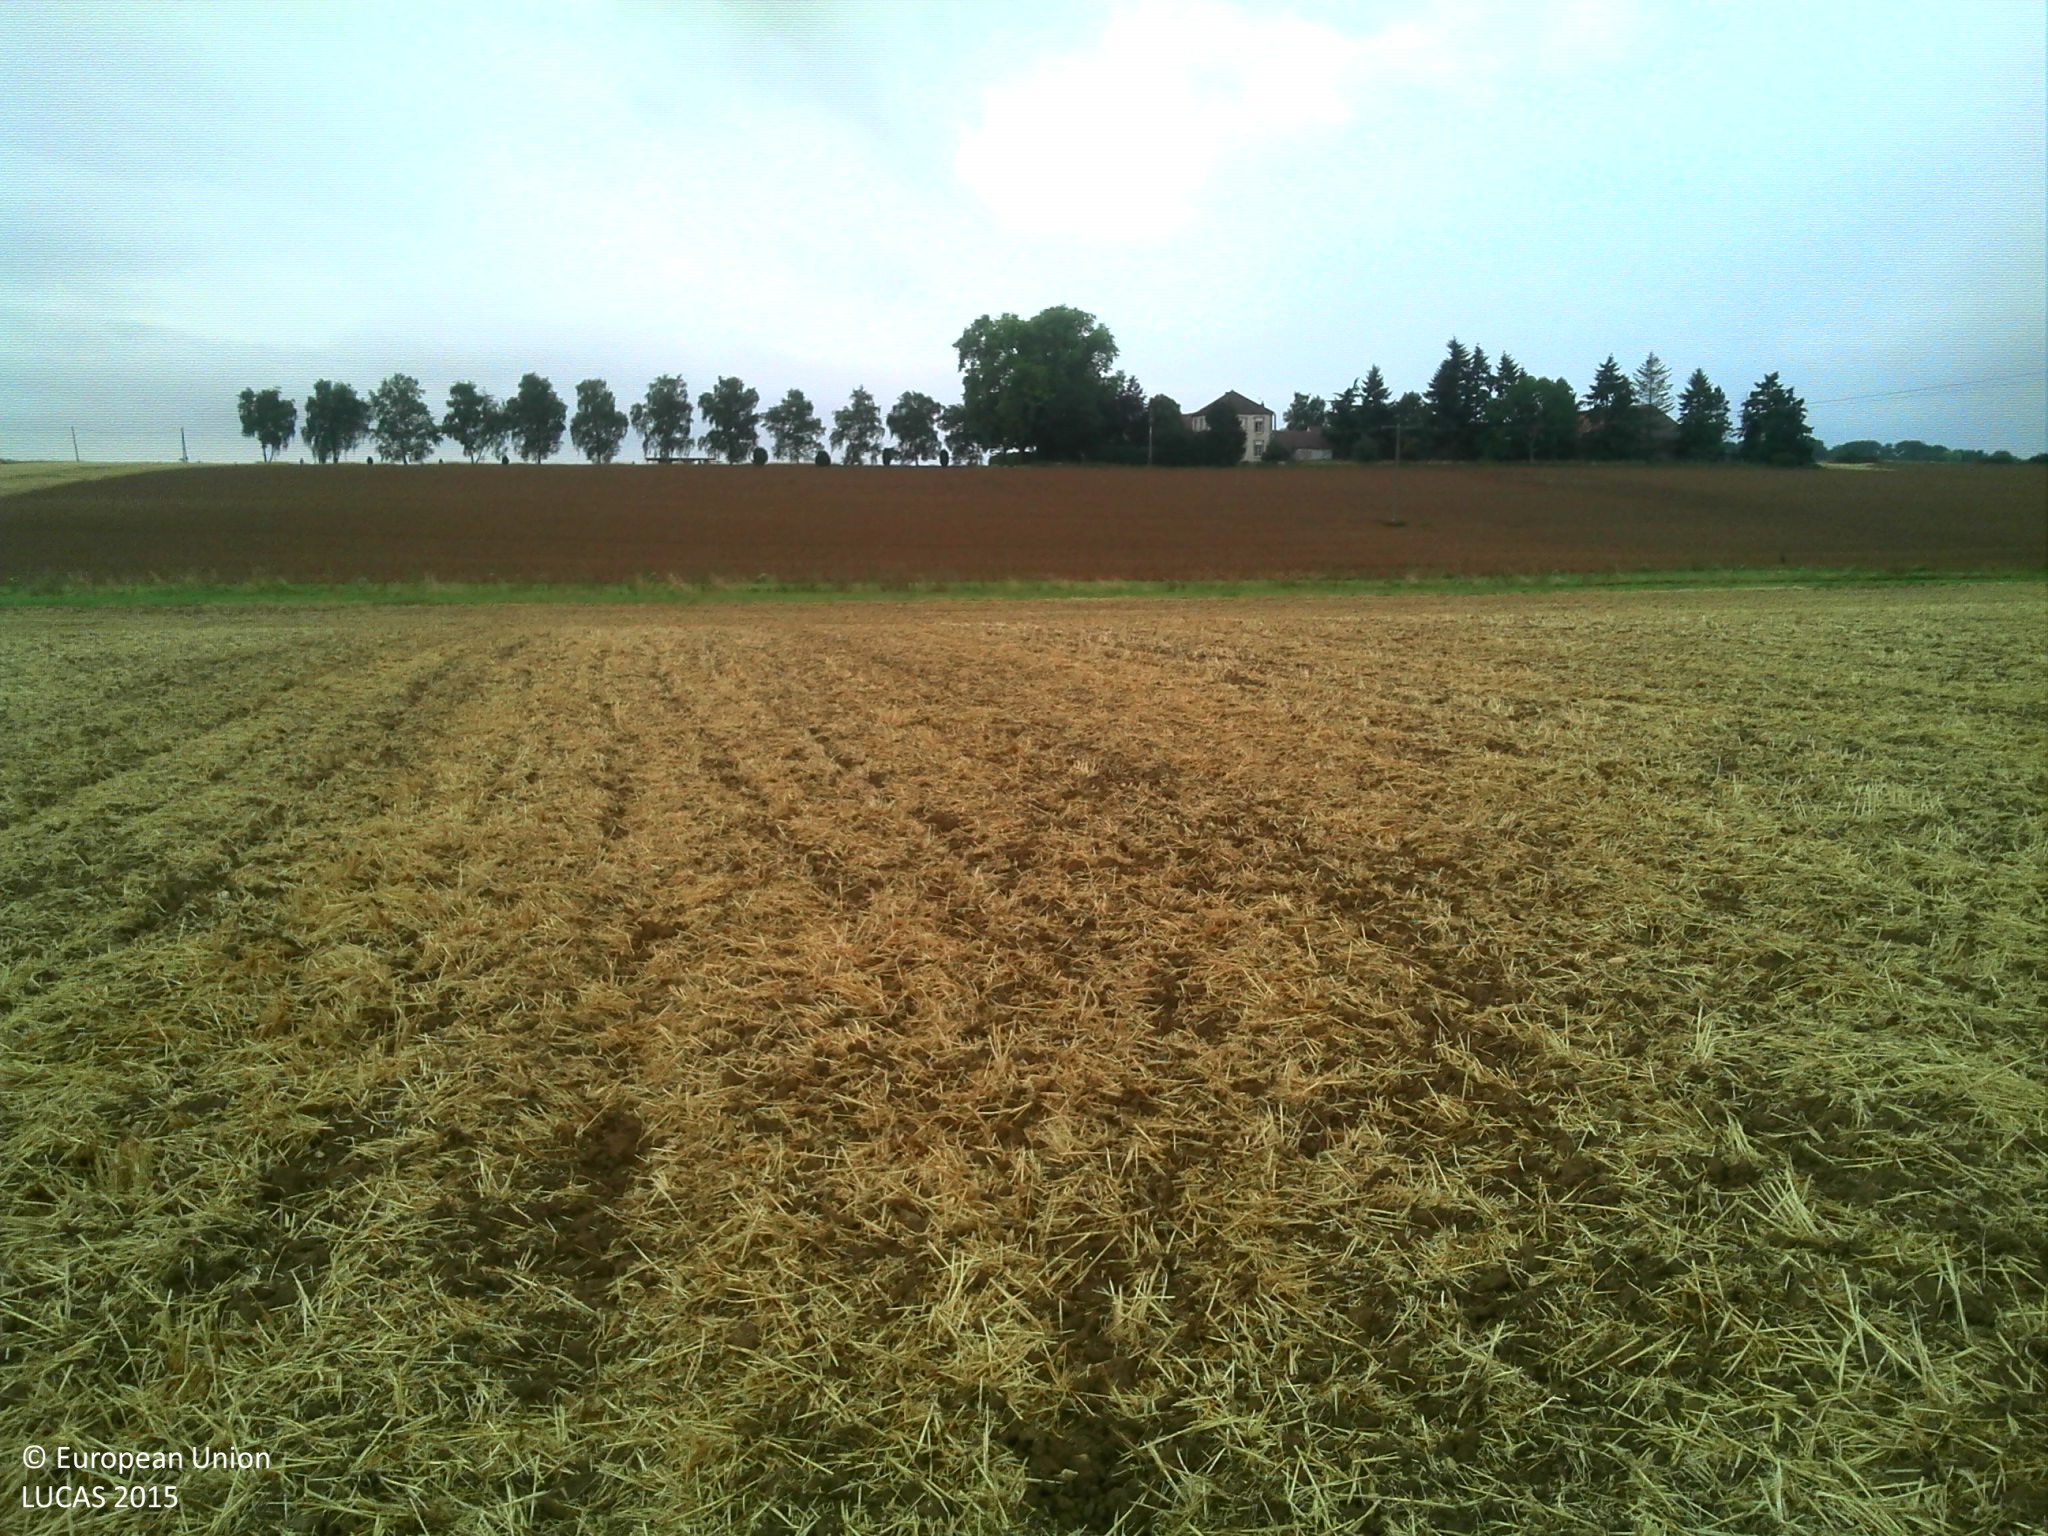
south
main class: Cropland
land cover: Common wheat
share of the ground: > 75 %
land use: Agriculture (excluding fallow land and kitchen gardens)
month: August
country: FR
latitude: 48.5279
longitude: 3.3446
